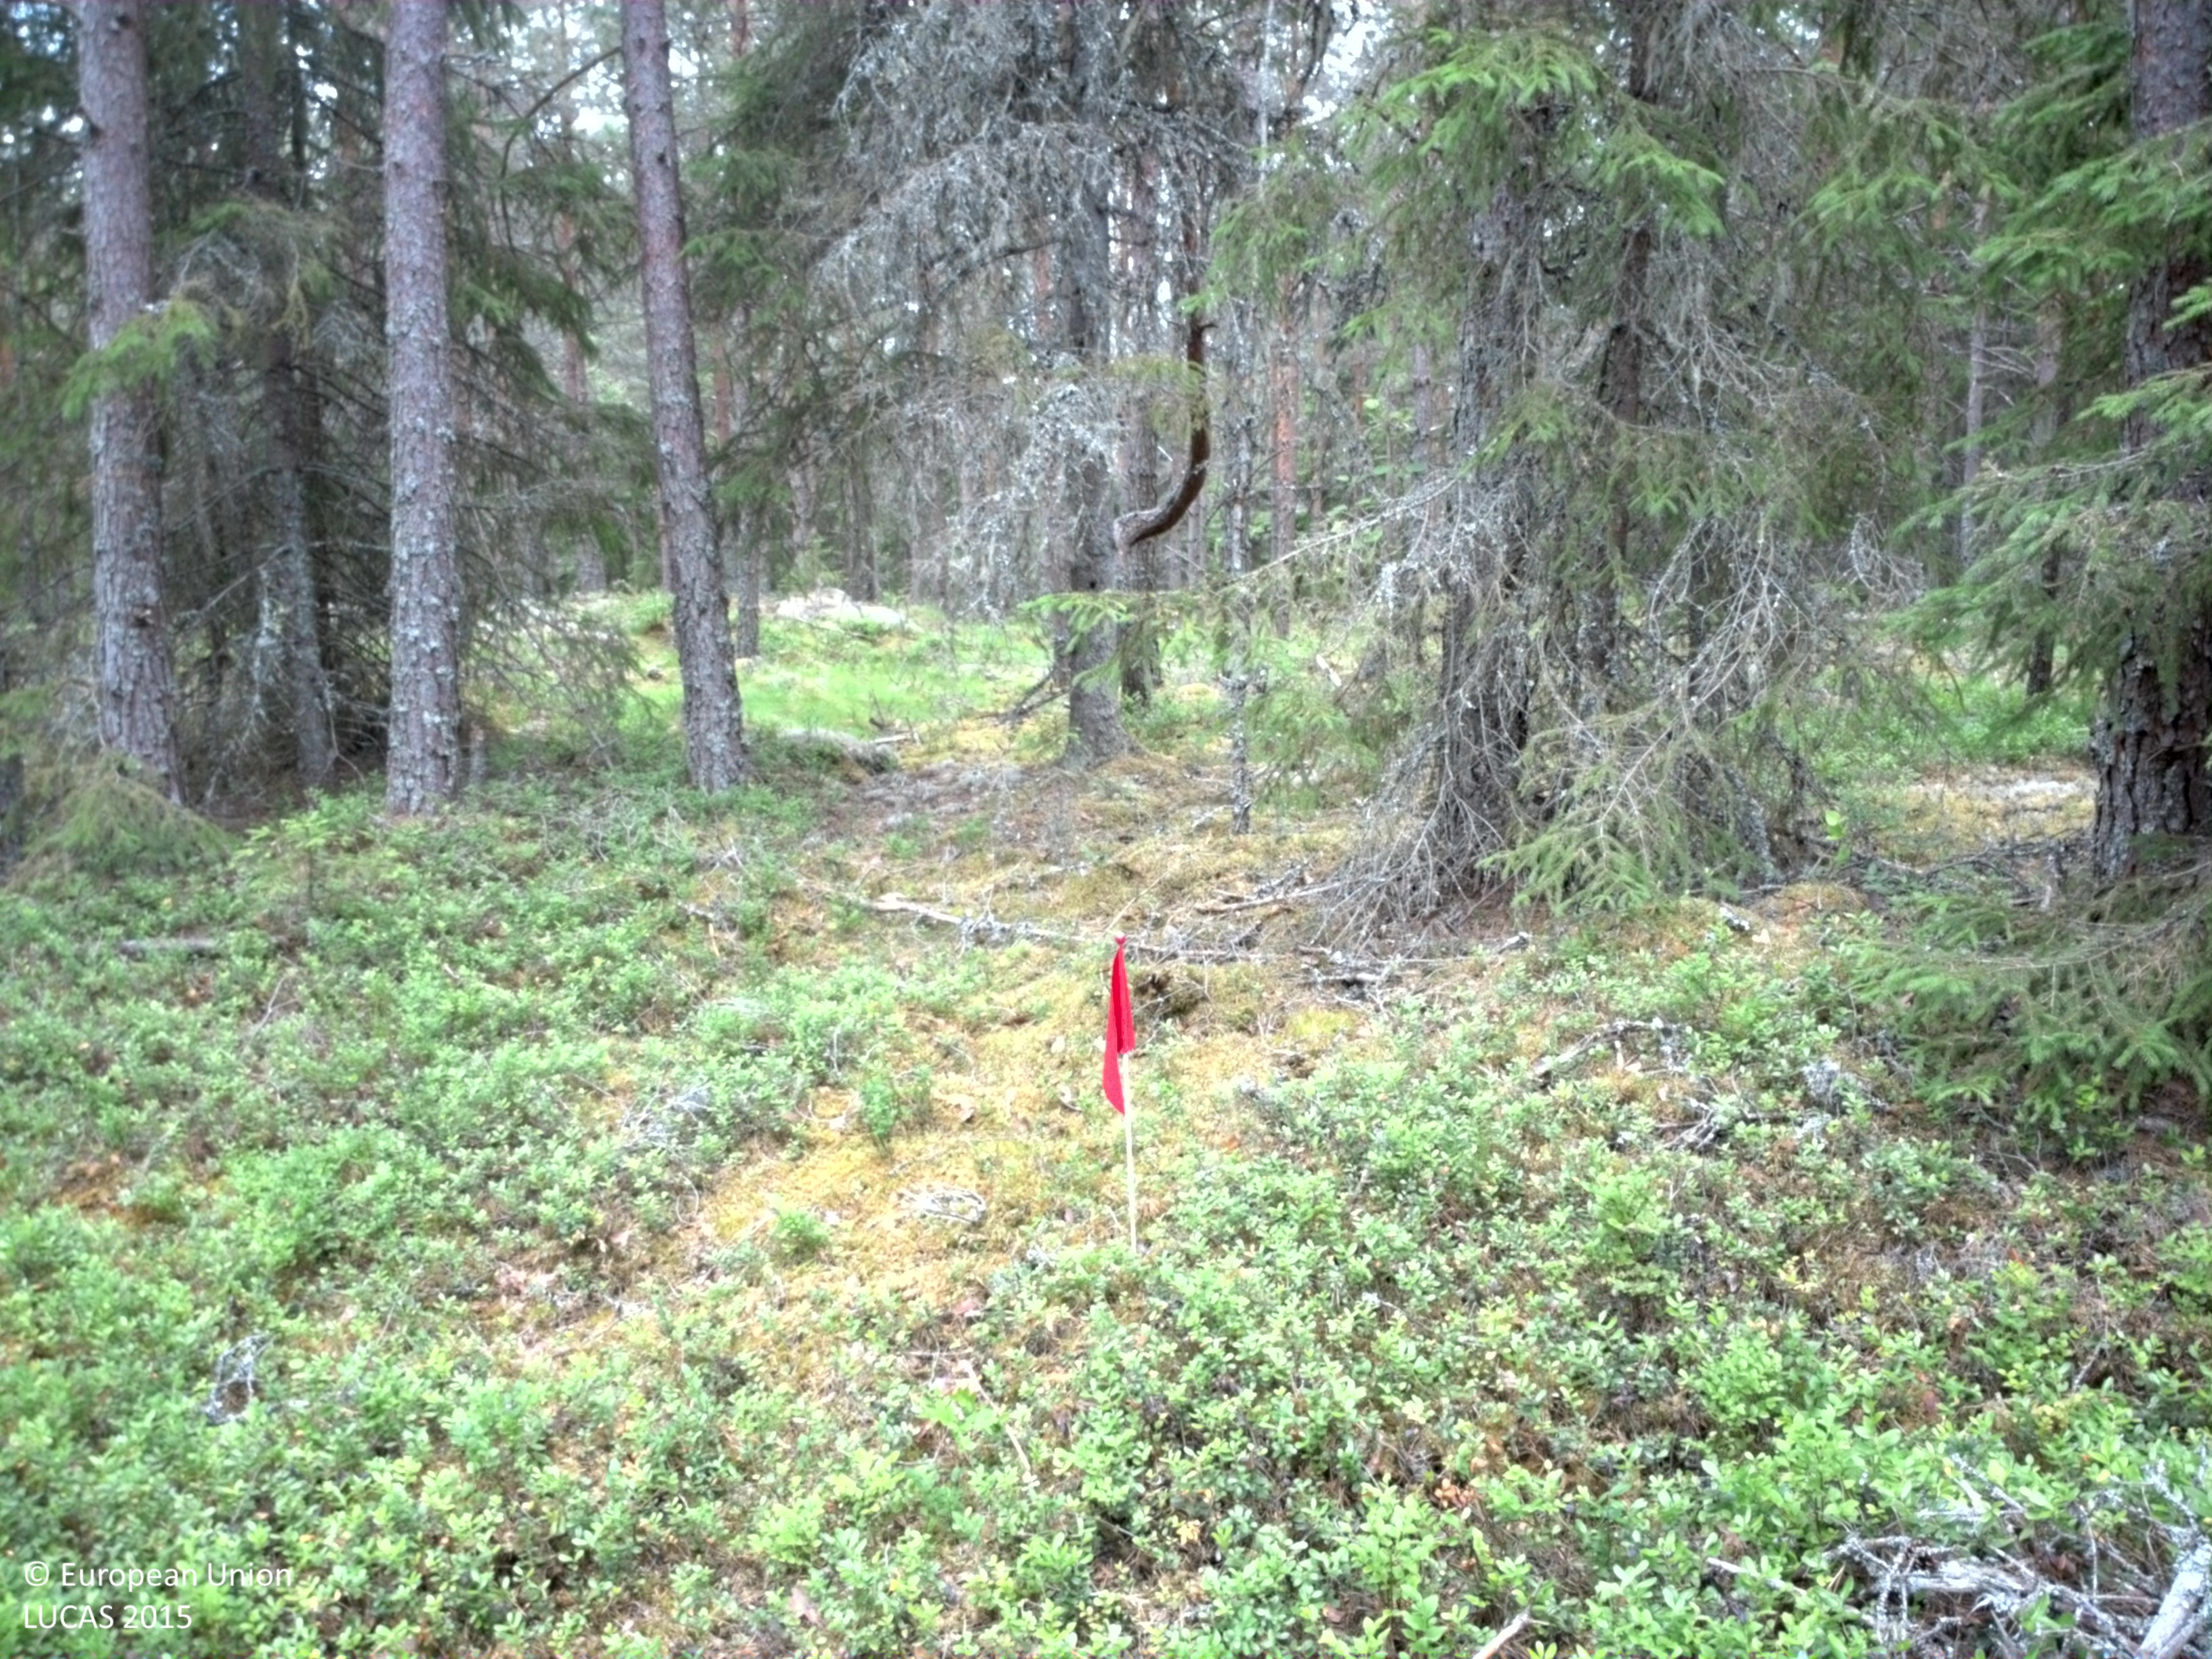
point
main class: Woodland
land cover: Pine dominated coniferous woodland
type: boreal forest
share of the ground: 25 - 50 %
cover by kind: coniferous forest trees 50 %, shrubs 25 %, lichens and mosses 20 %, herbaceous plants 5 %
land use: Forestry
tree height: > 5 m
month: July
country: SE
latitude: 59.6638
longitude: 11.8941
